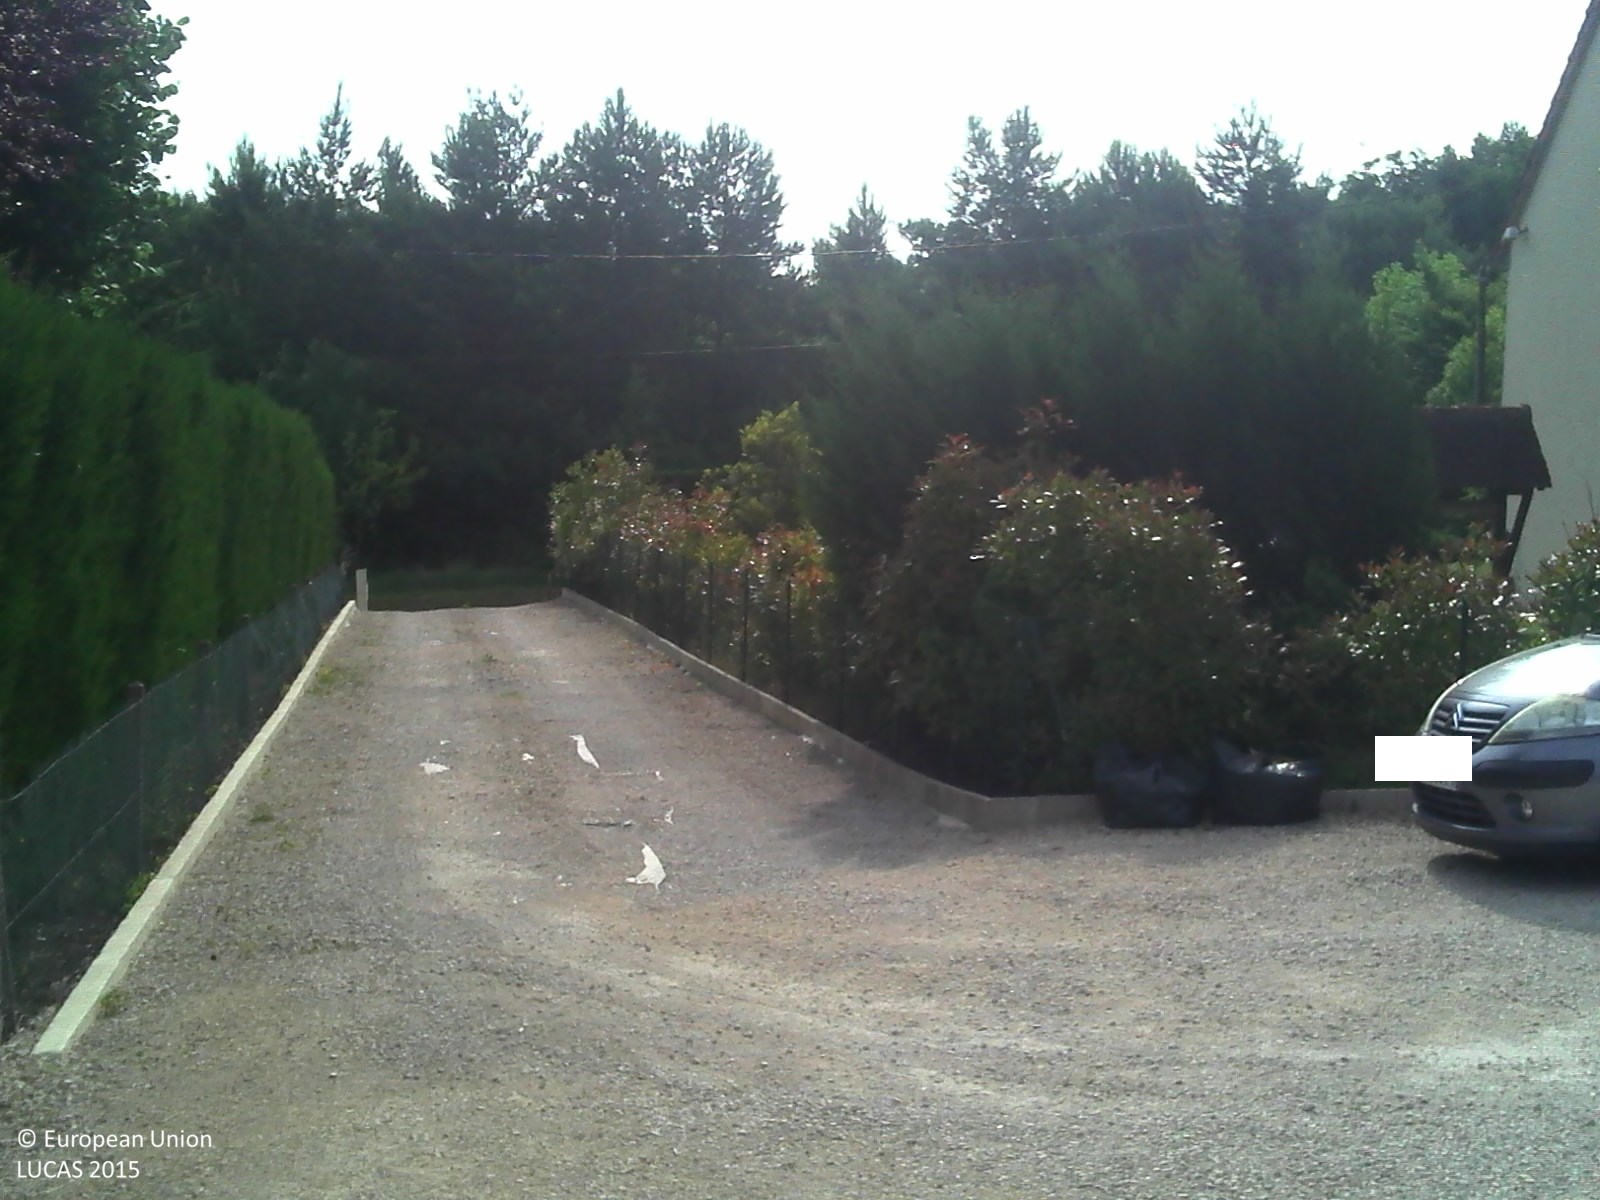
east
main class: Grassland
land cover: Grassland with sparse tree/shrub cover
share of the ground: > 75 %
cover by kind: herbaceous plants 95 %, broadleaved forest trees 5 %
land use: Agriculture (excluding fallow land and kitchen gardens)
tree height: < 5 m
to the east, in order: Grassland with sparse tree/shrub cover; Artificial constructions in urban areas; Broadleaved woodland; Vineyards; Tracks; Fences; Broadleaved woodland; Spontaneously vegetated surfaces
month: June
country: FR
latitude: 47.5265
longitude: 1.4187
